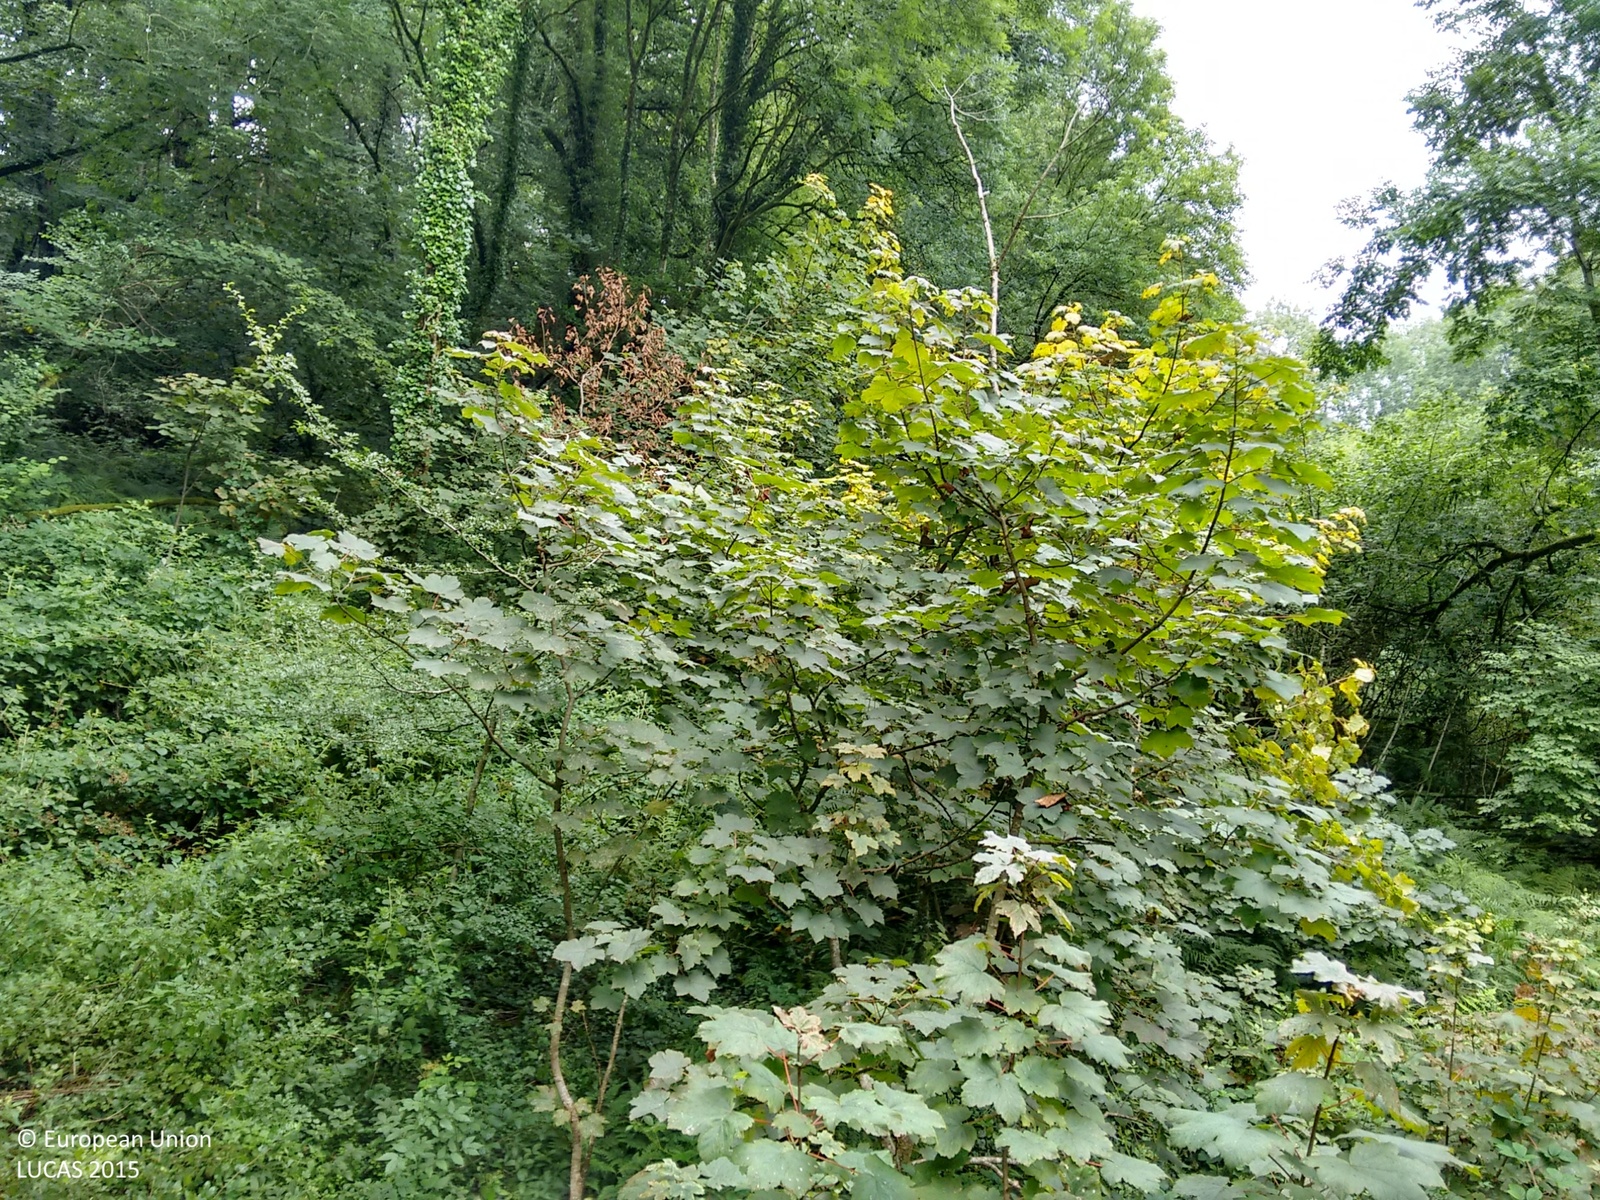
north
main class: Woodland
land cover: Broadleaved woodland
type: mesophytic deciduous forest
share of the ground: > 75 %
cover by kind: broadleaved forest trees 60 %, shrubs 40 %
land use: Semi-natural and natural areas not in use
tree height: > 5 m
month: August
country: GB
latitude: 51.8259
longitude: -4.6622
